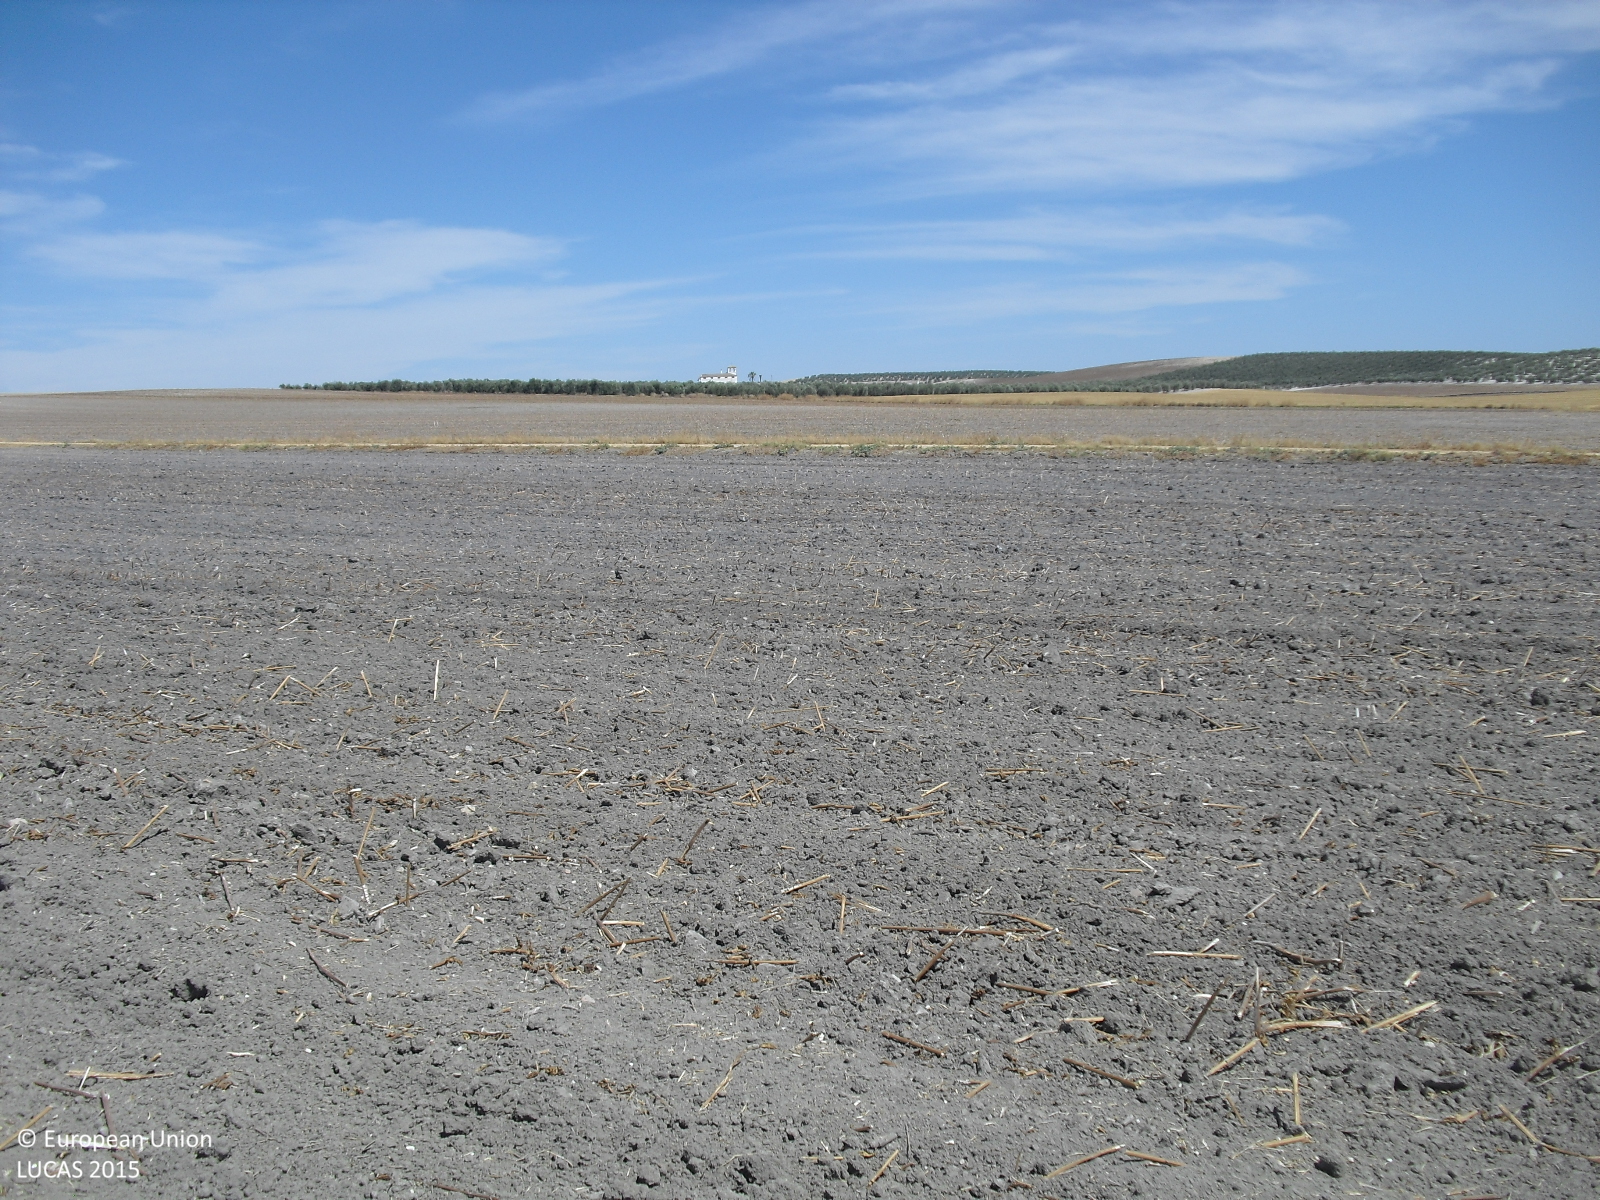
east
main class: Cropland
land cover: Sunflower
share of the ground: < 10 %
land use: Agriculture (excluding fallow land and kitchen gardens)
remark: Harvested field
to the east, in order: Sunflower; Grass margins; Tracks; Grass margins; Sunflower
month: August
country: ES
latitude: 37.3959
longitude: -5.5716
